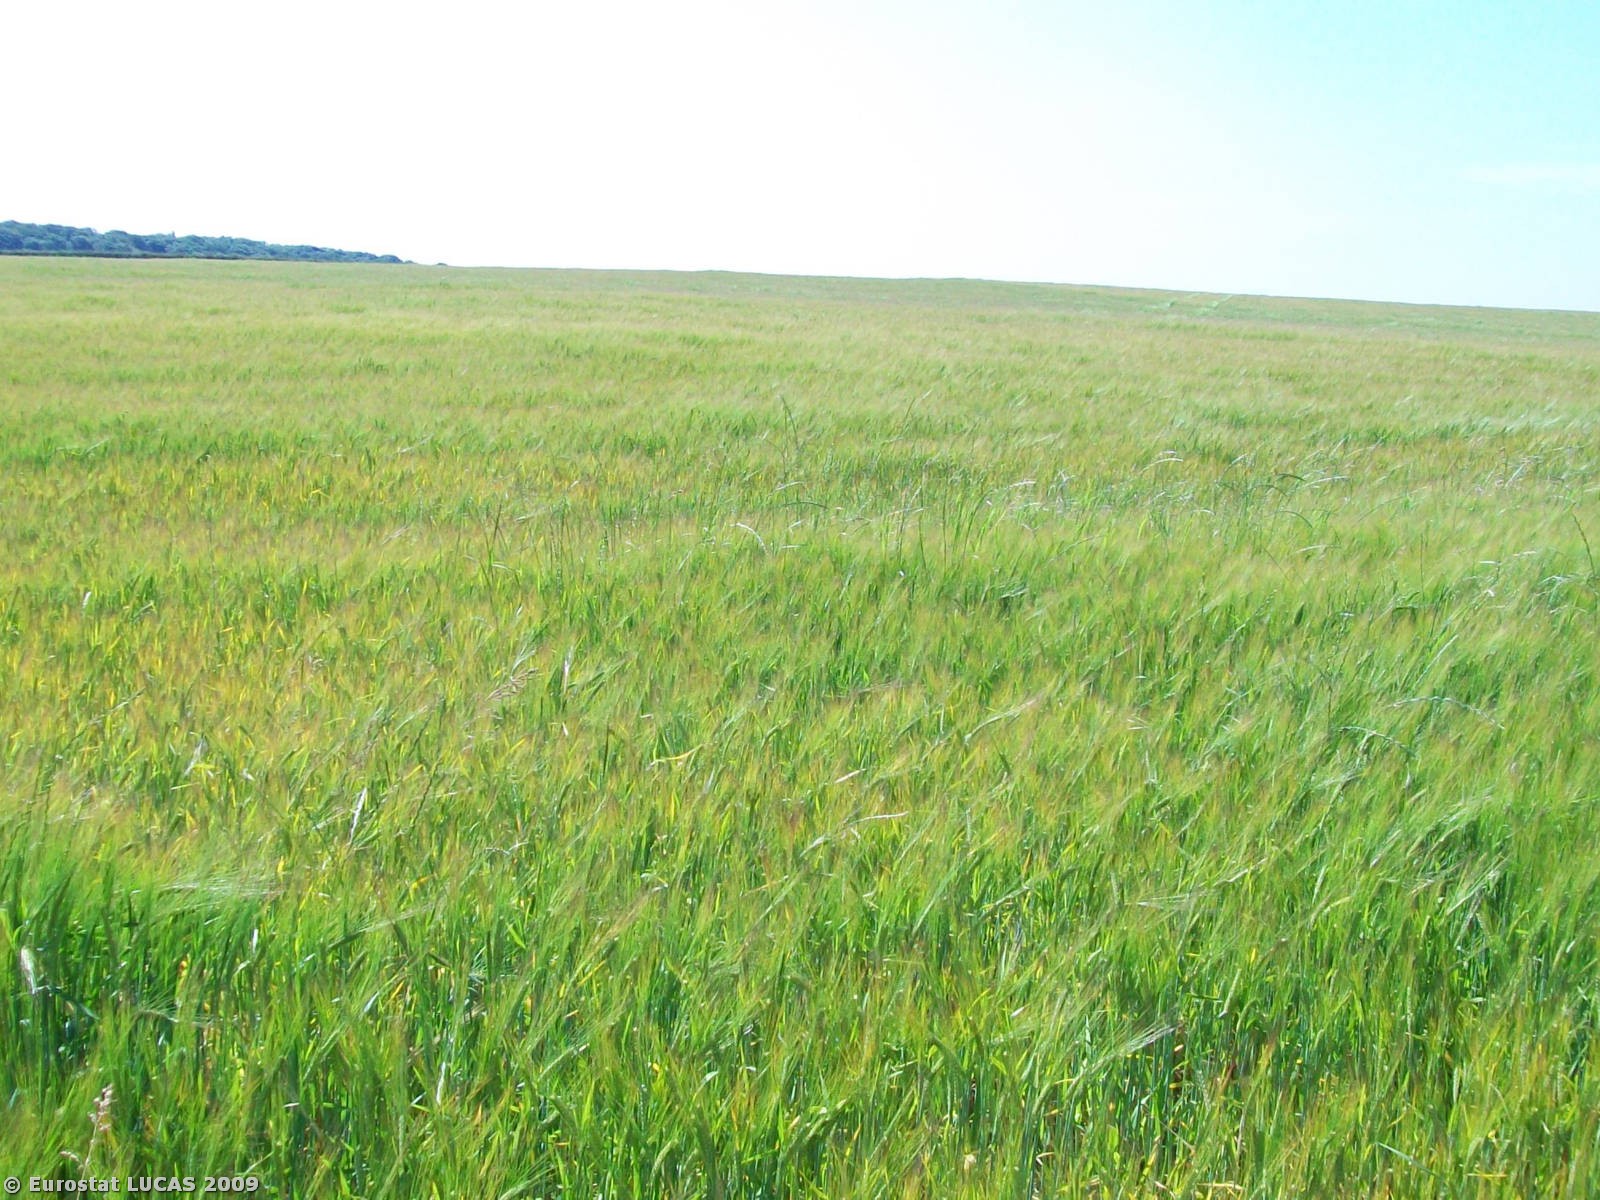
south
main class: Cropland
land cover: Barley
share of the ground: < 10 %
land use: Agriculture (excluding fallow land and kitchen gardens)
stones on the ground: 25 - 50 %
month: July
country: GB
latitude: 53.8955
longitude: -1.4159
